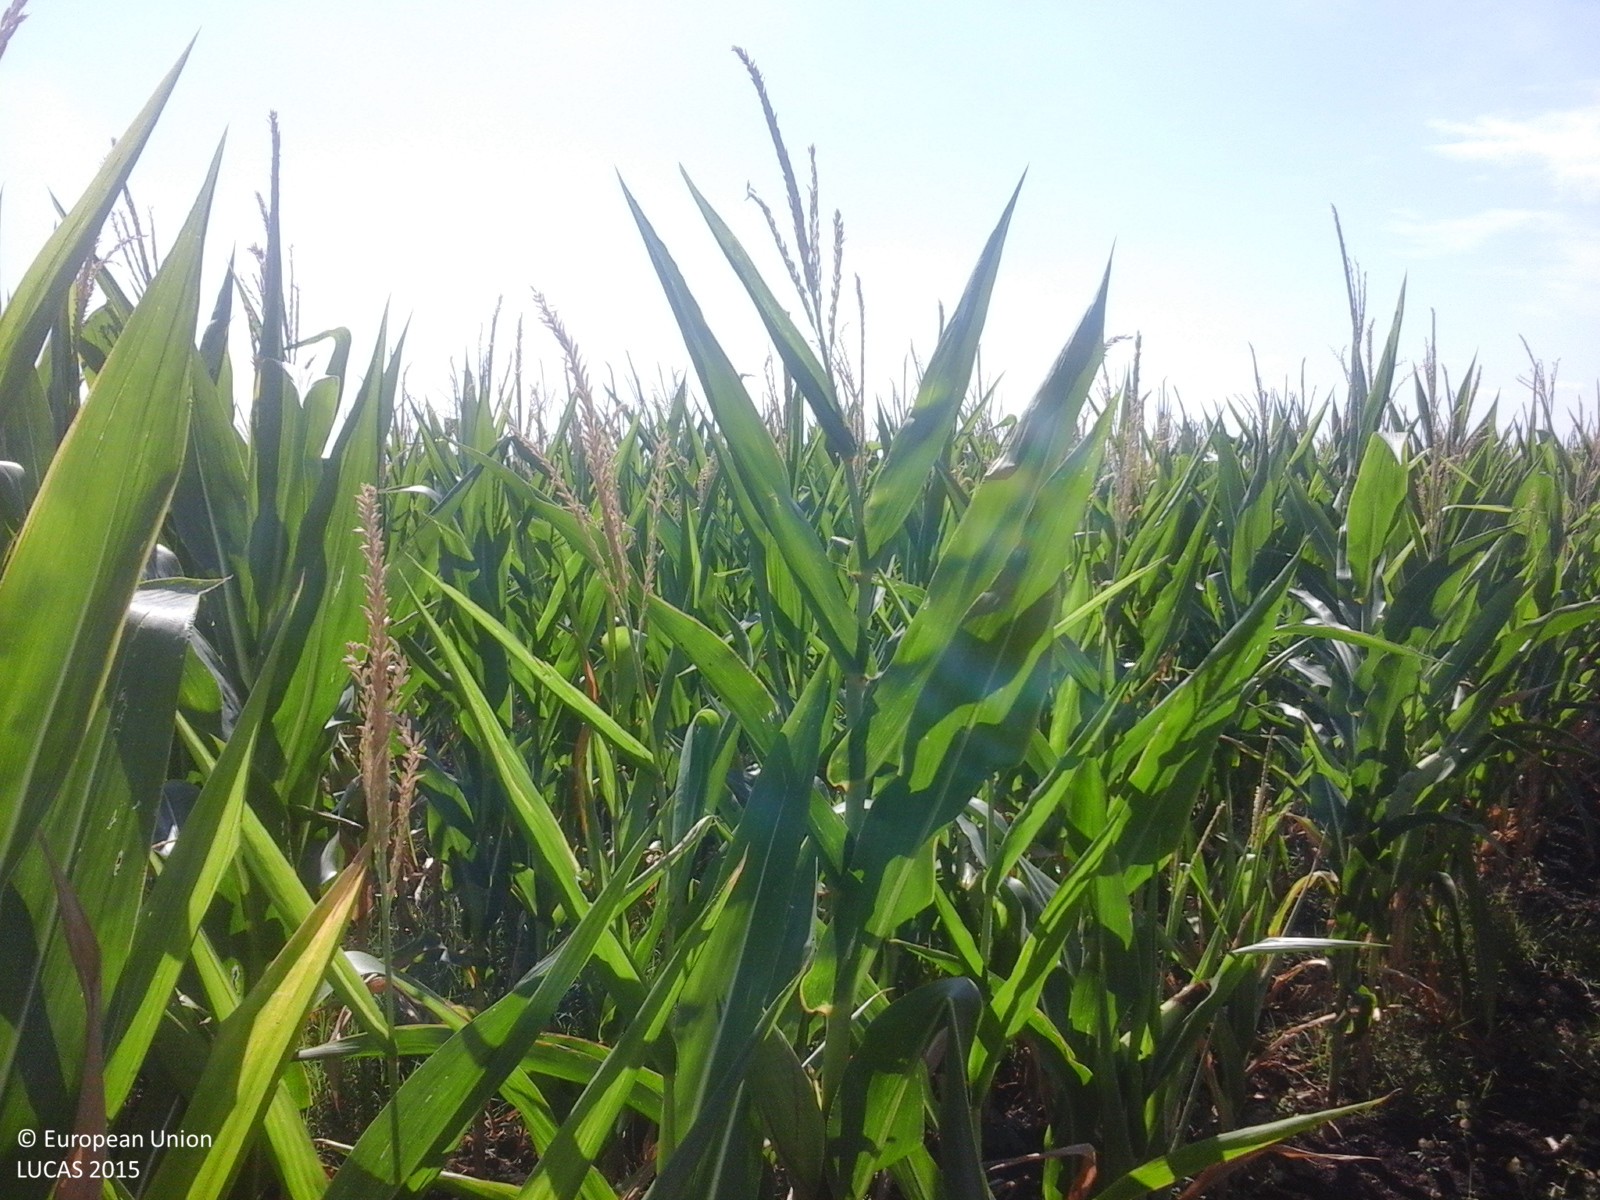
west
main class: Cropland
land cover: Maize
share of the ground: > 75 %
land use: Agriculture (excluding fallow land and kitchen gardens)
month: August
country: RO
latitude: 45.3161
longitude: 21.4473
